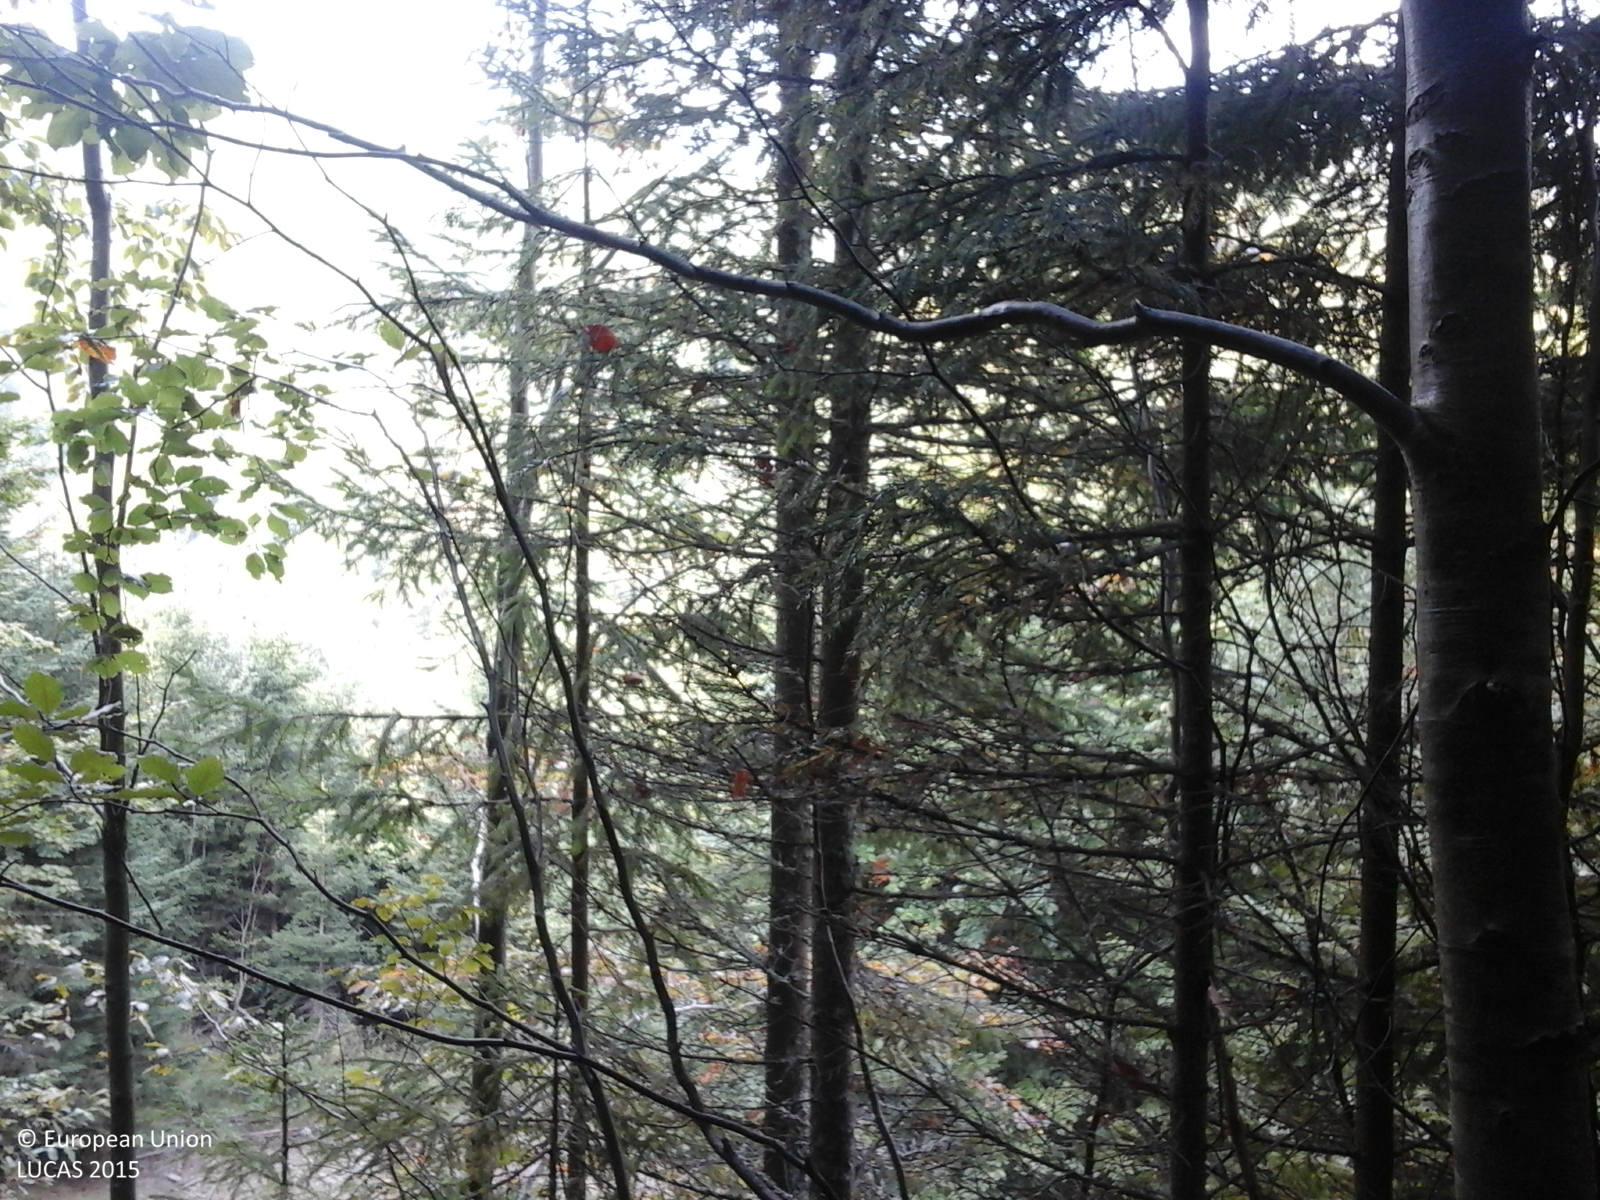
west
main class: Woodland
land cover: Spruce dominated mixed woodland
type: alpine coniferous forest
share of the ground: > 75 %
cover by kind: coniferous forest trees 60 %, broadleaved forest trees 40 %
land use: Forestry
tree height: > 5 m
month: September
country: RO
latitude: 45.2731
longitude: 22.9112
